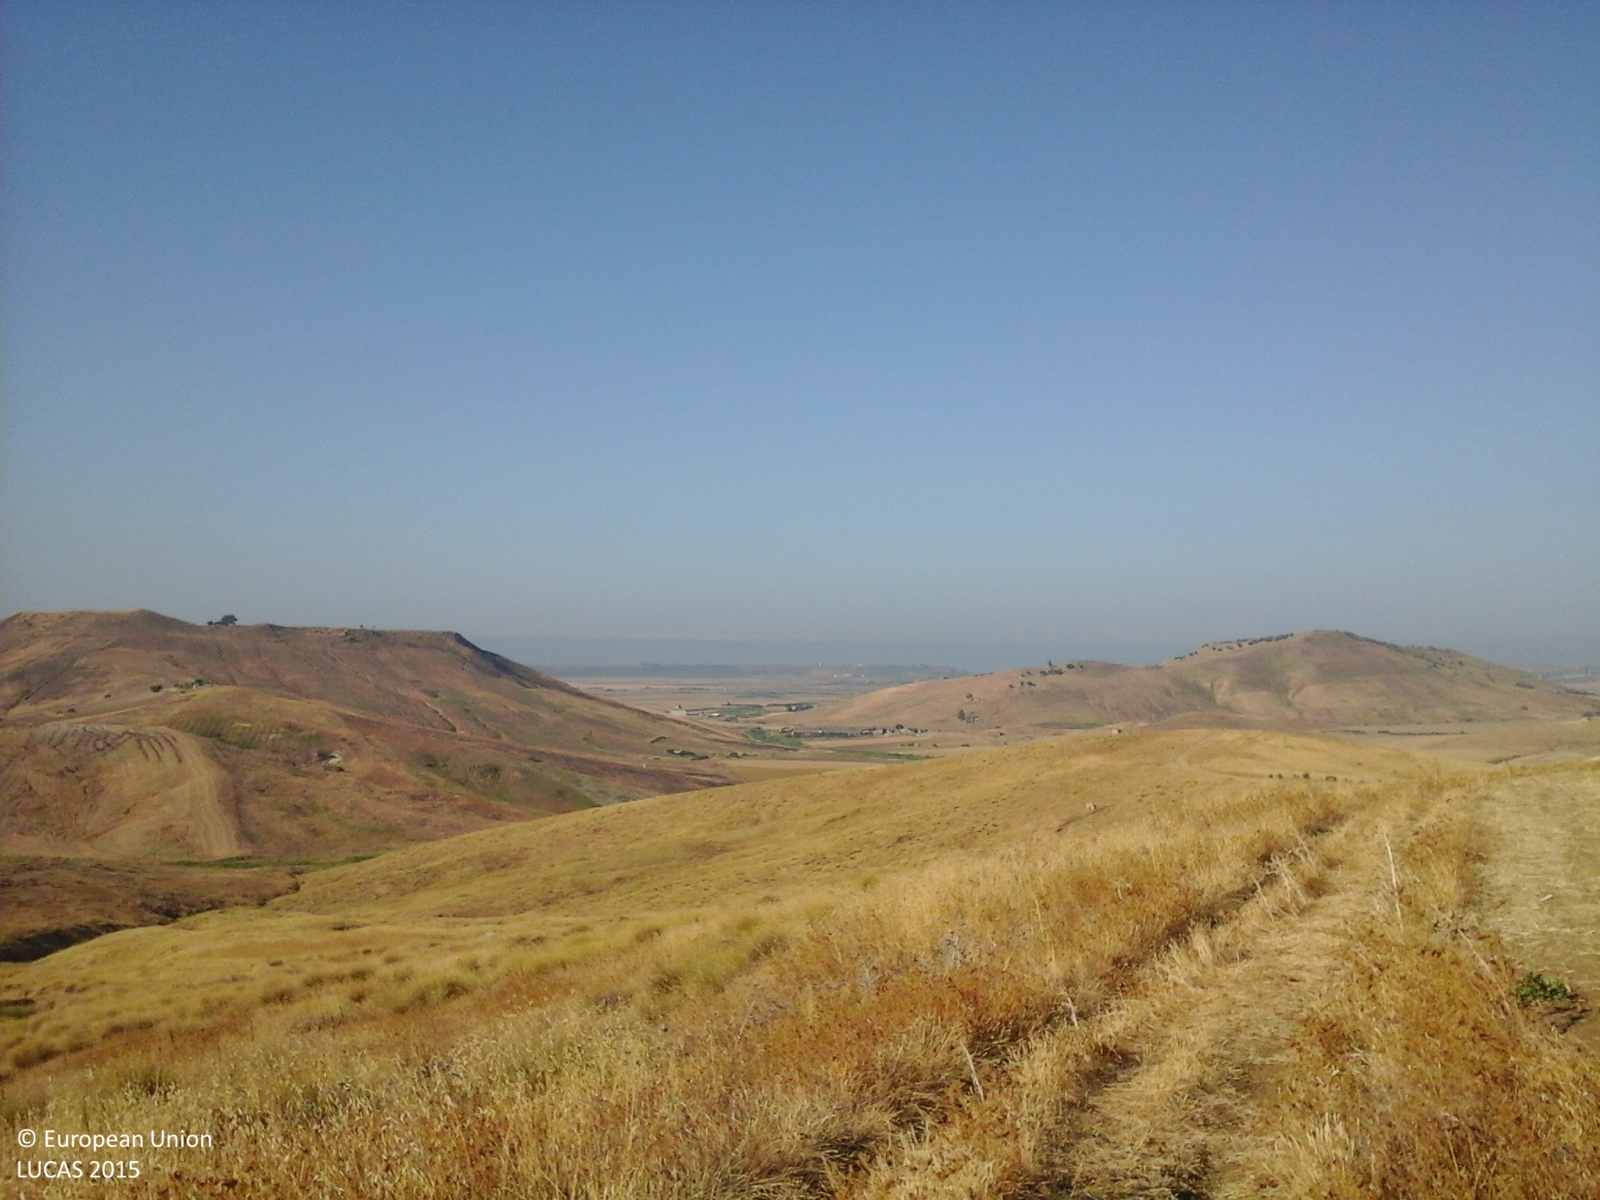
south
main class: Grassland
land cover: Grassland without tree/shrub cover
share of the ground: > 75 %
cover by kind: herbaceous plants 100 %
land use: Semi-natural and natural areas not in use
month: July
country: IT
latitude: 37.1442
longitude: 14.2338
